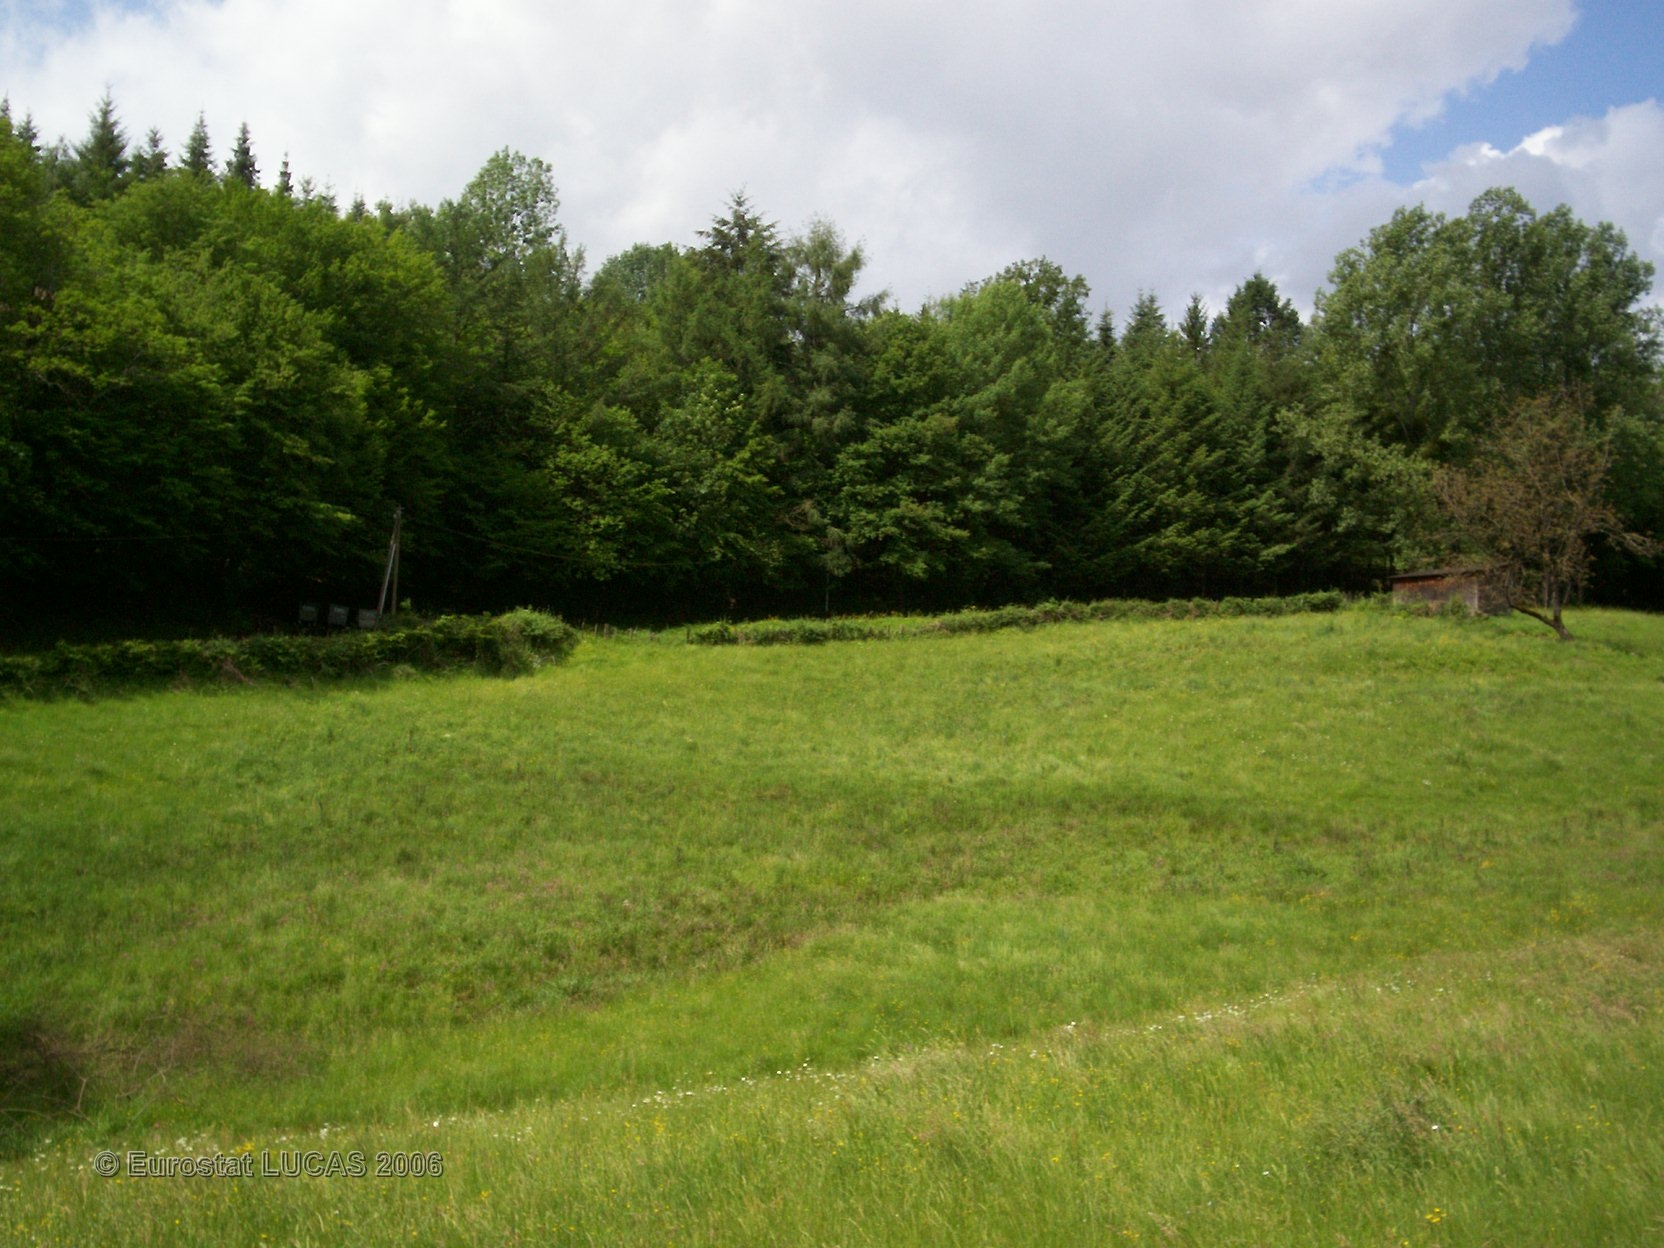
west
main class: Grassland
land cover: Grassland without tree/shrub cover
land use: Agriculture (excluding fallow land and kitchen gardens)
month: May
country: FR
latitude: 45.2577
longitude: 1.8025
